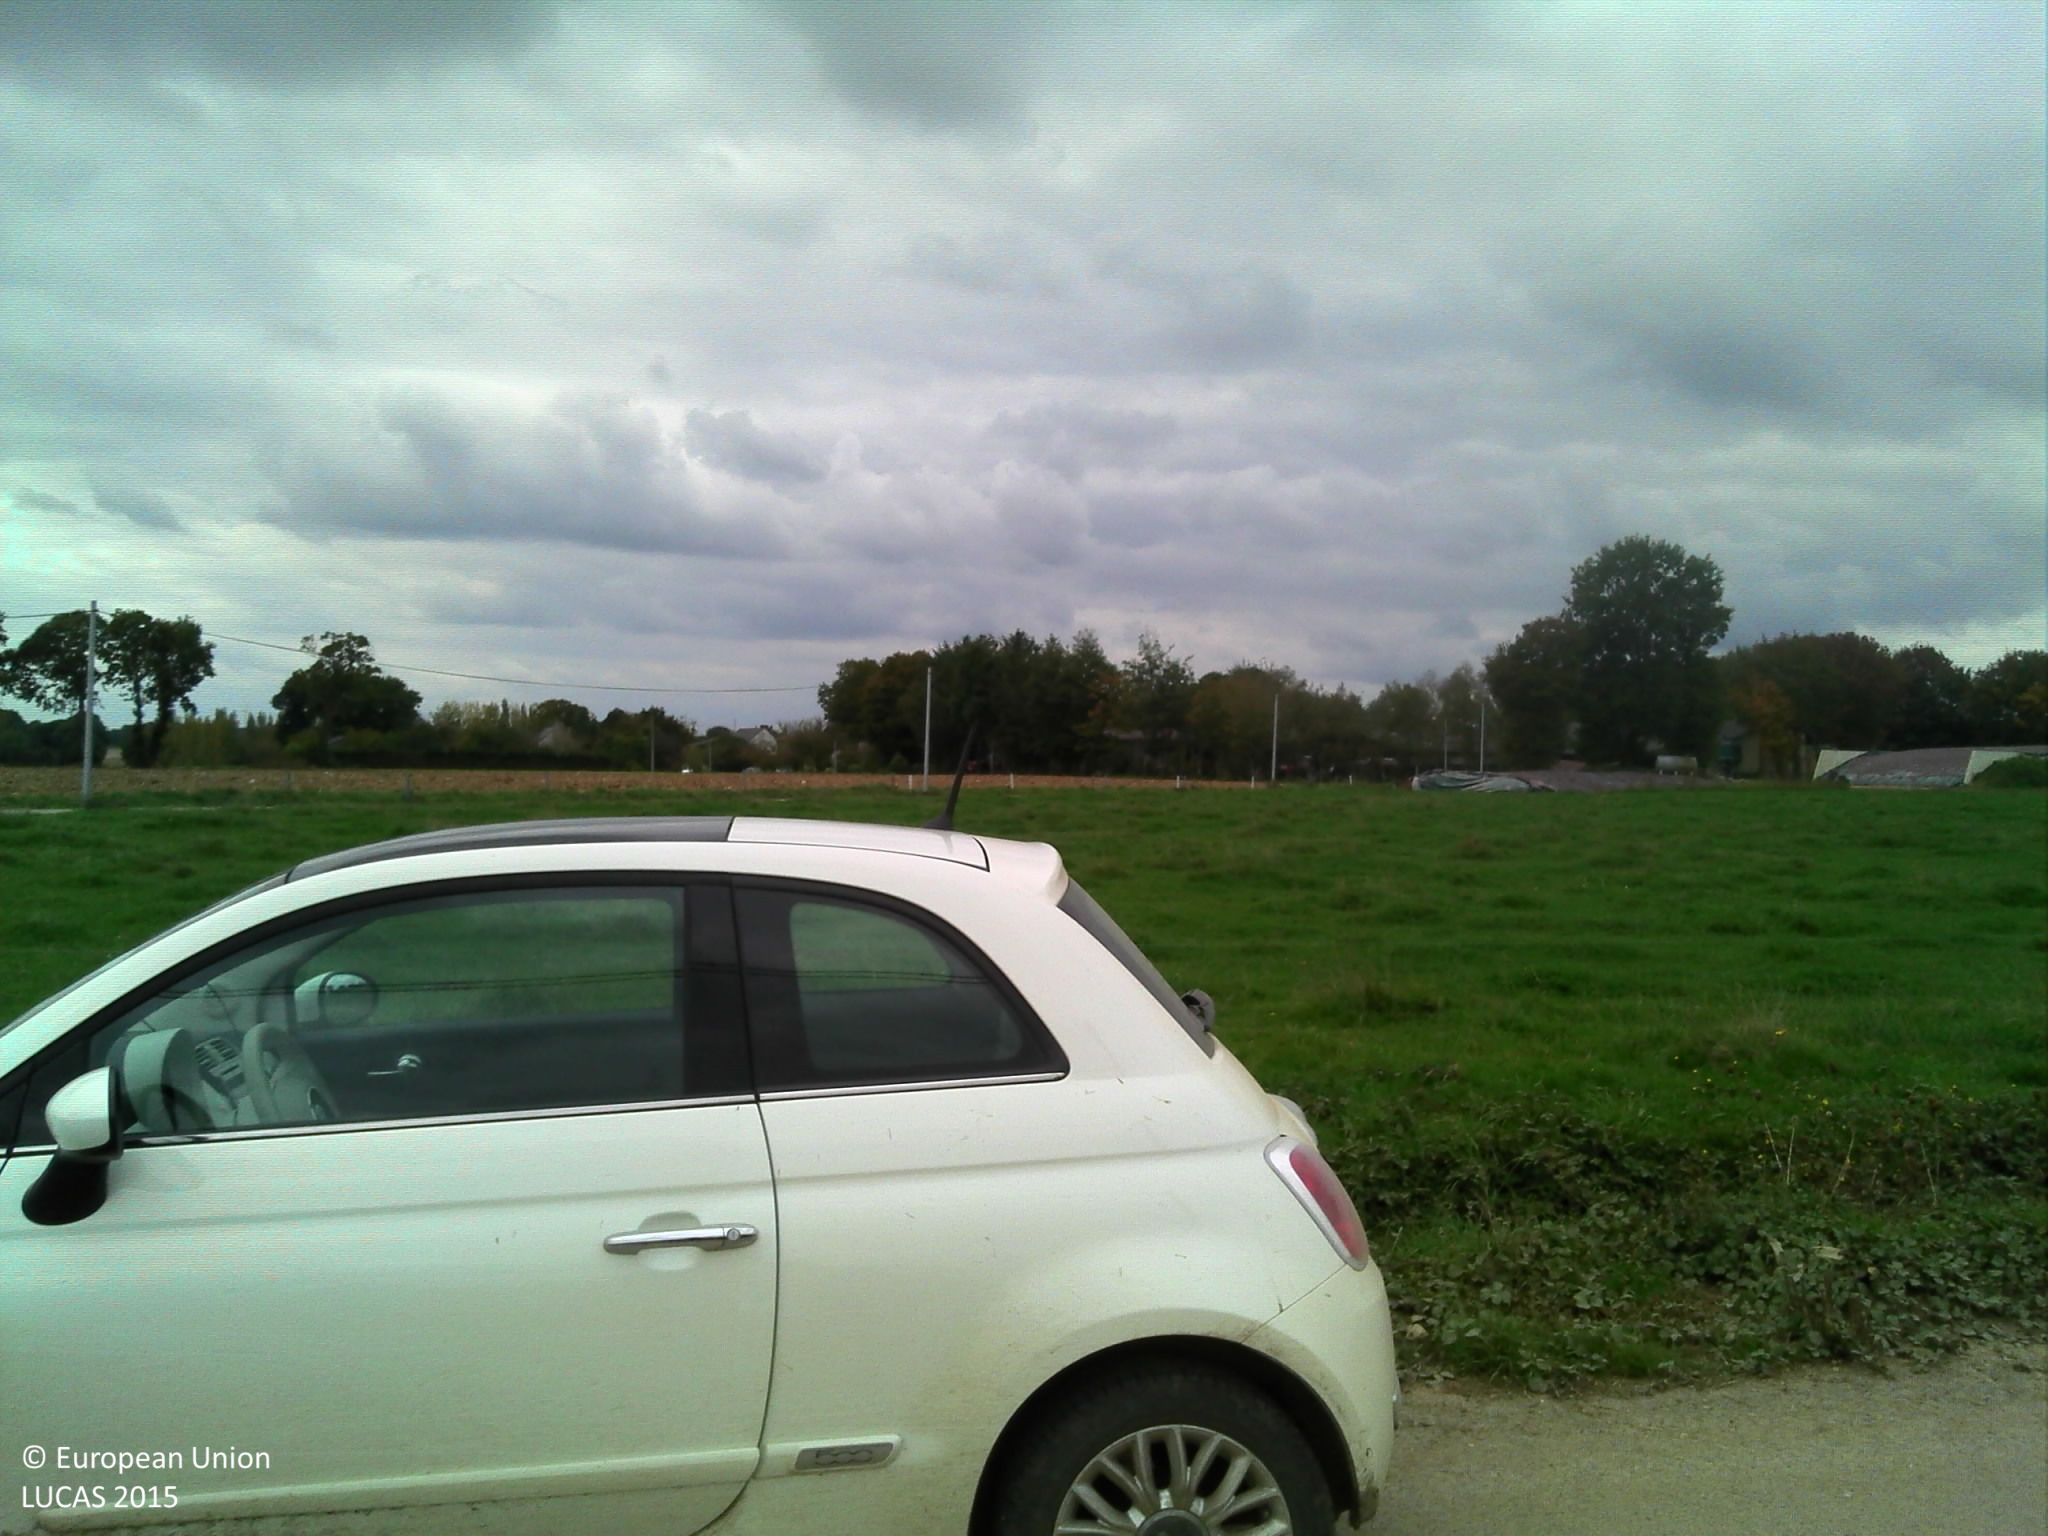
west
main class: Grassland
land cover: Grassland without tree/shrub cover
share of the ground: > 75 %
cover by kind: herbaceous plants 100 %
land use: Agriculture (excluding fallow land and kitchen gardens)
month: October
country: FR
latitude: 48.1028
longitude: -2.3999
